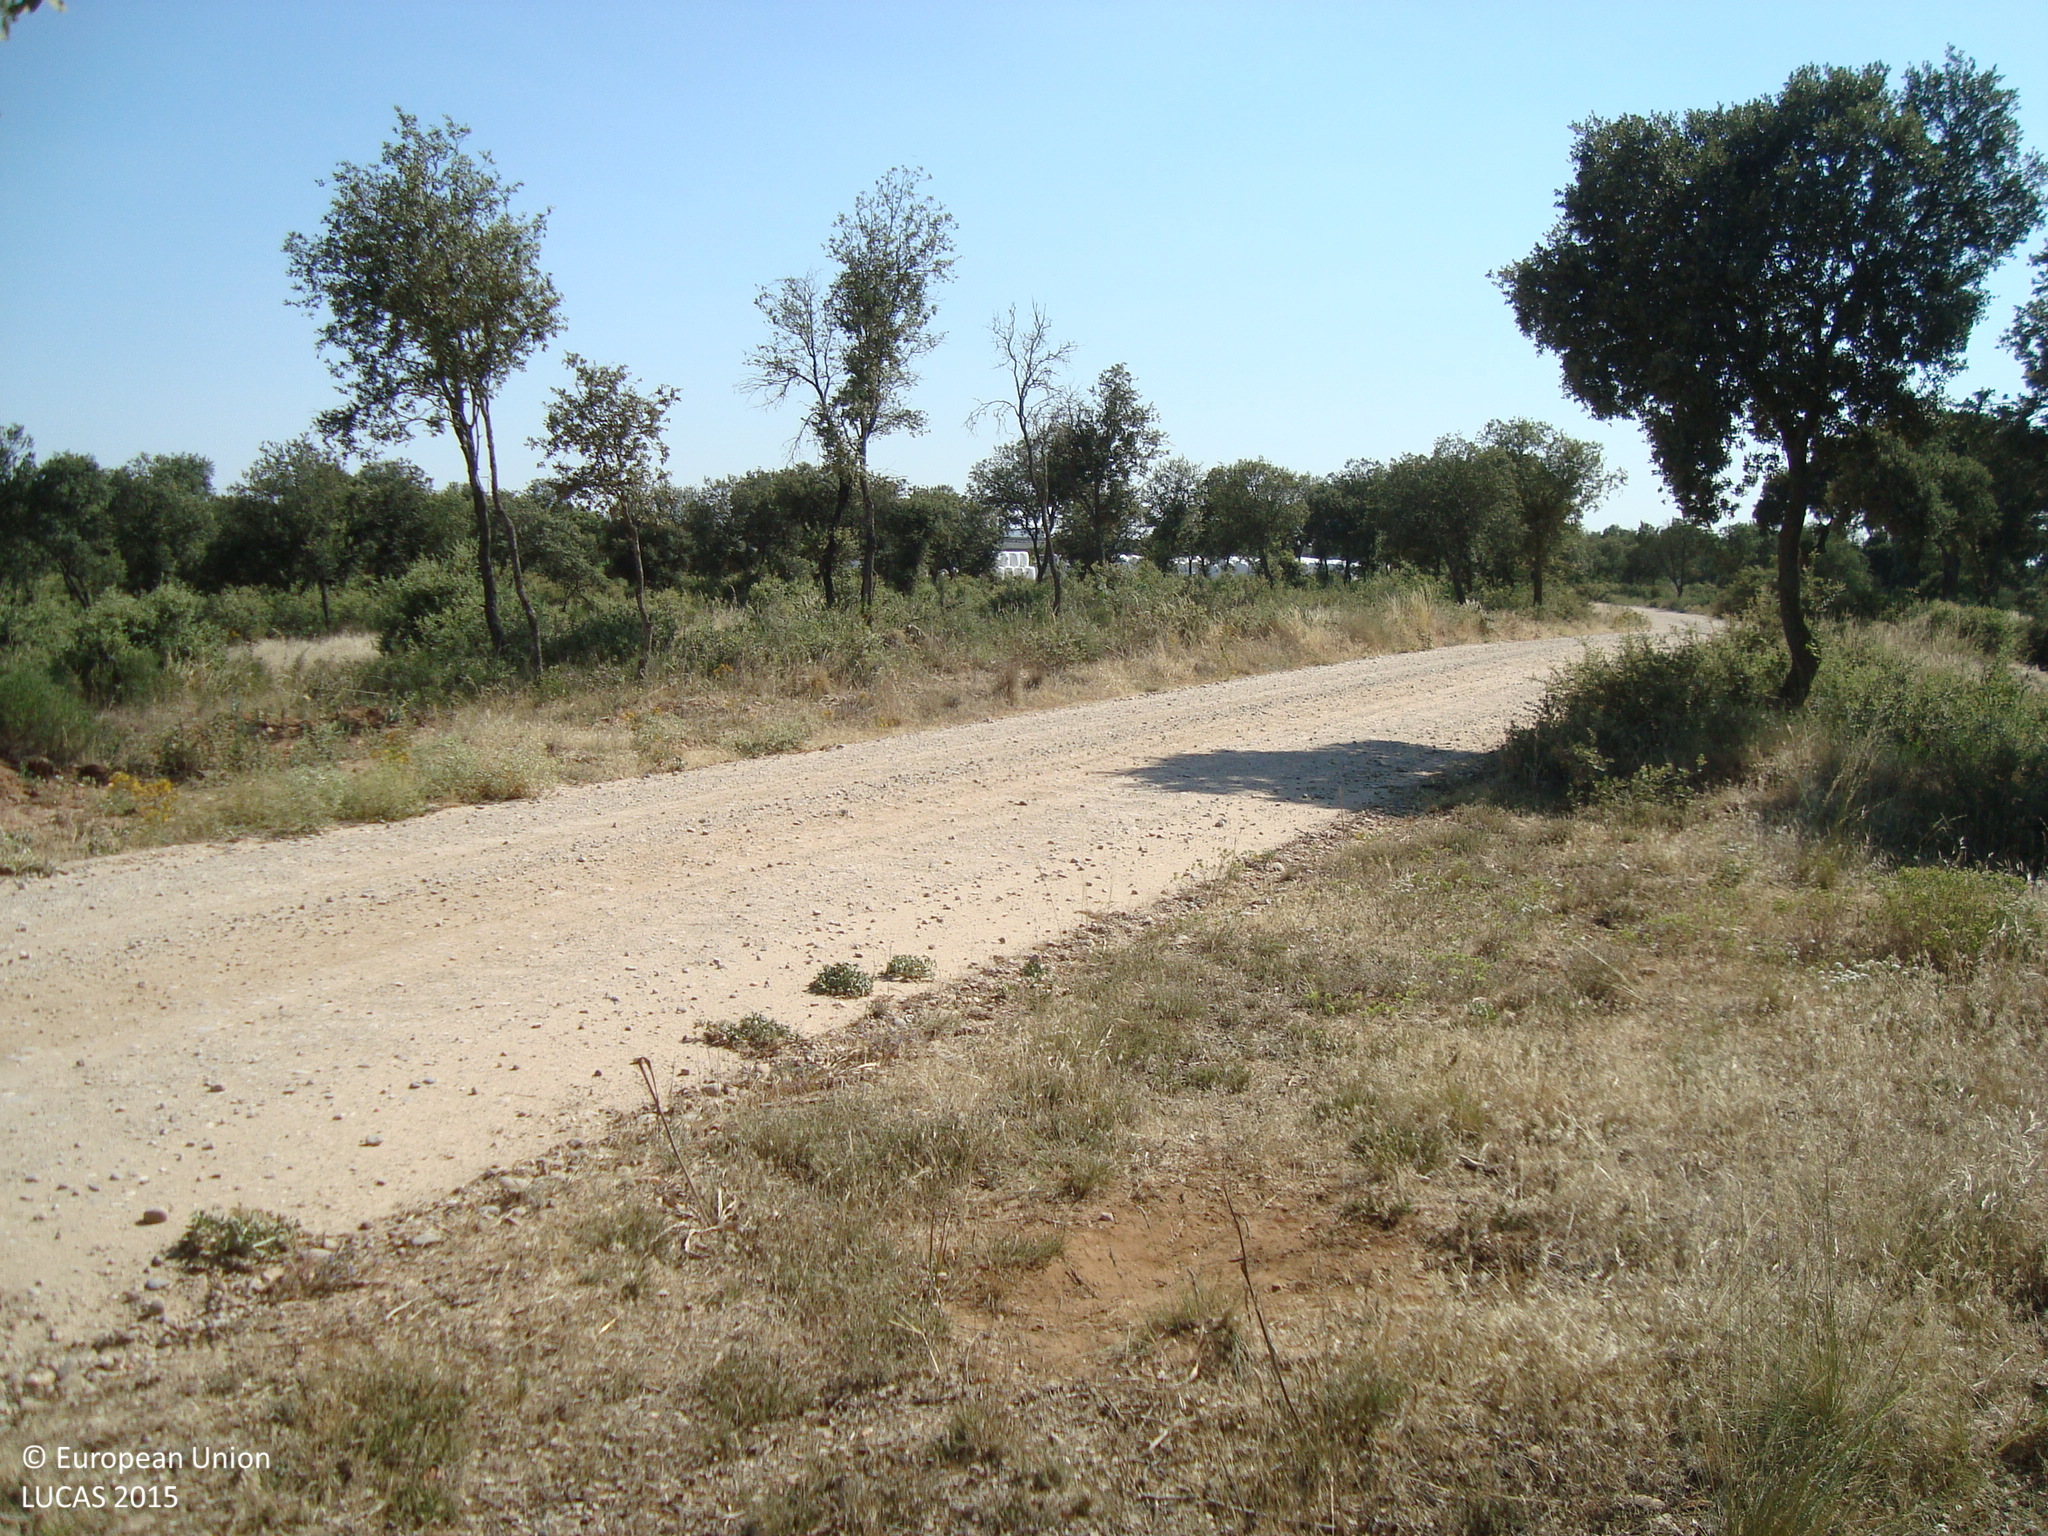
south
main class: Cropland
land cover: Sugar beet
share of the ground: > 75 %
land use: Agriculture (excluding fallow land and kitchen gardens)
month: July
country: ES
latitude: 42.0596
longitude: -4.2651
